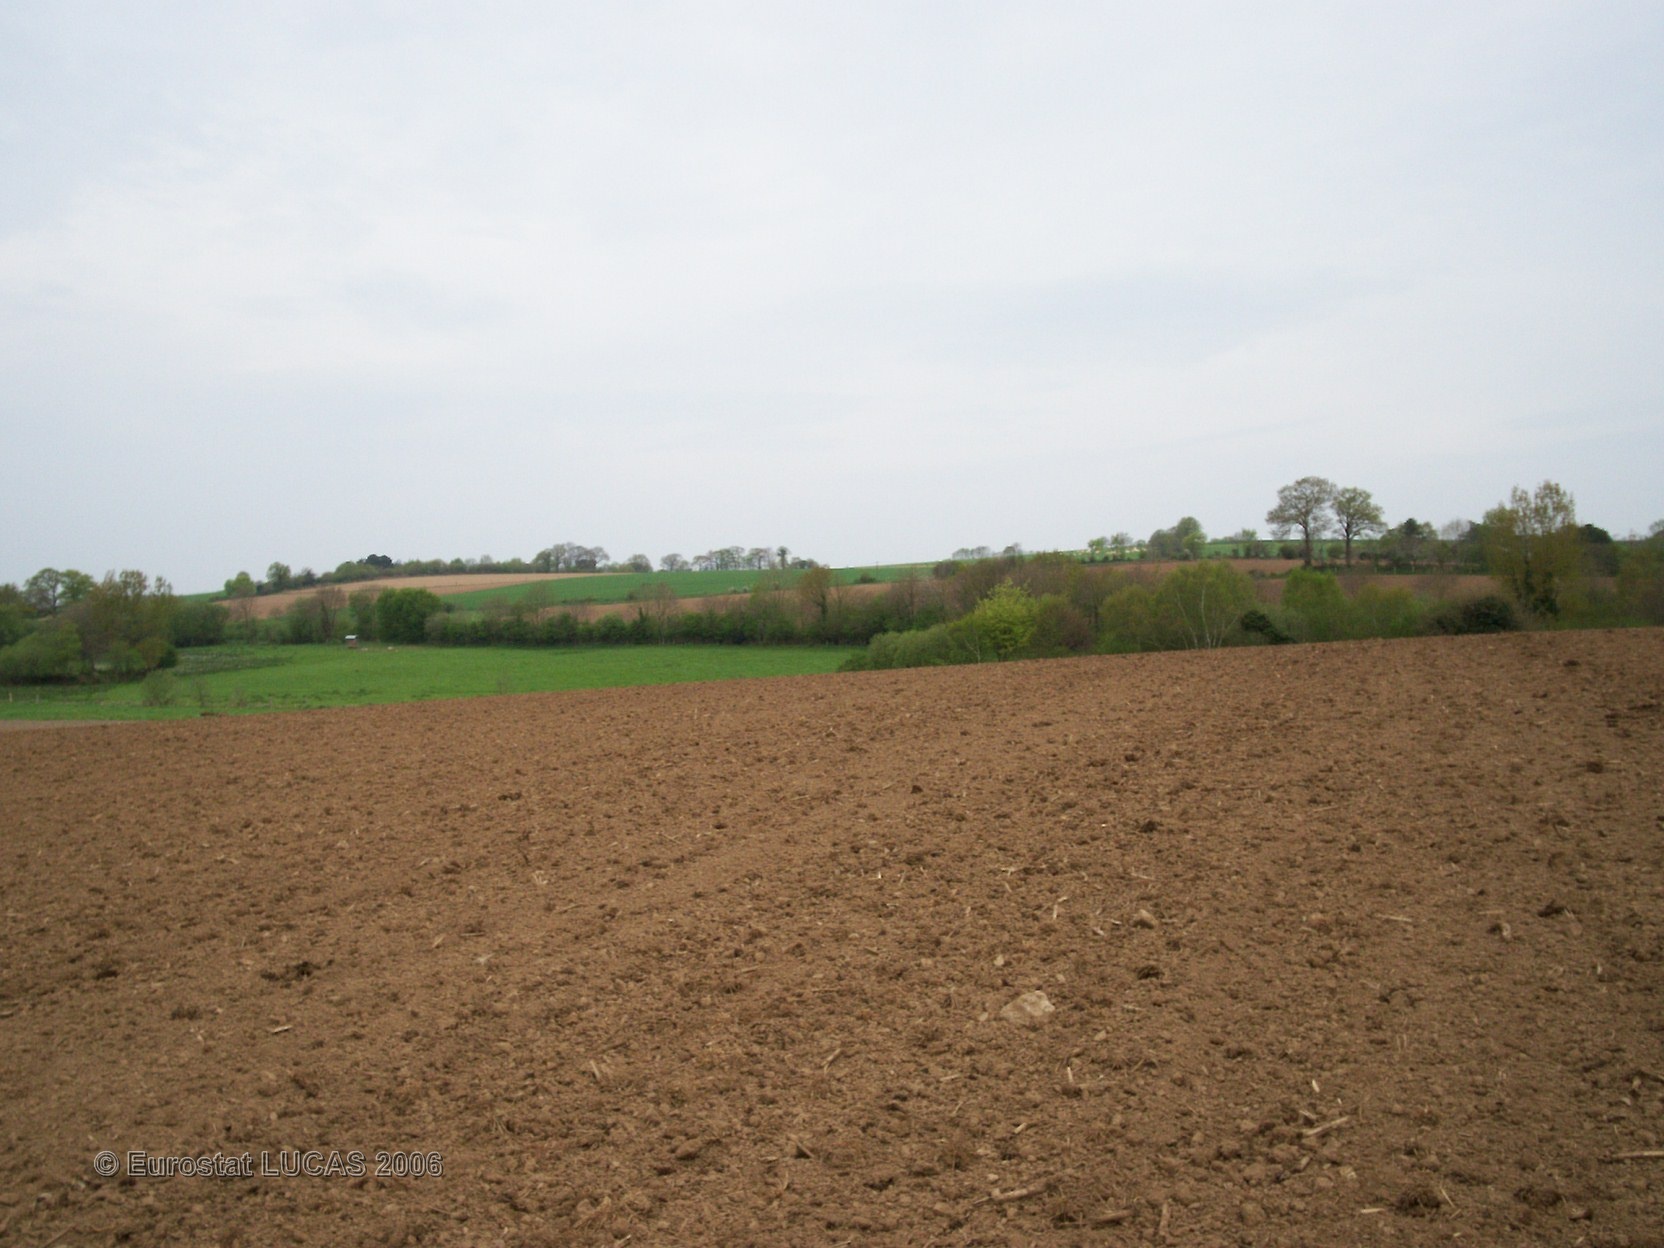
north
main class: Cropland
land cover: Maize
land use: Agriculture (excluding fallow land and kitchen gardens)
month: May
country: FR
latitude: 48.2273
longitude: -3.9383
